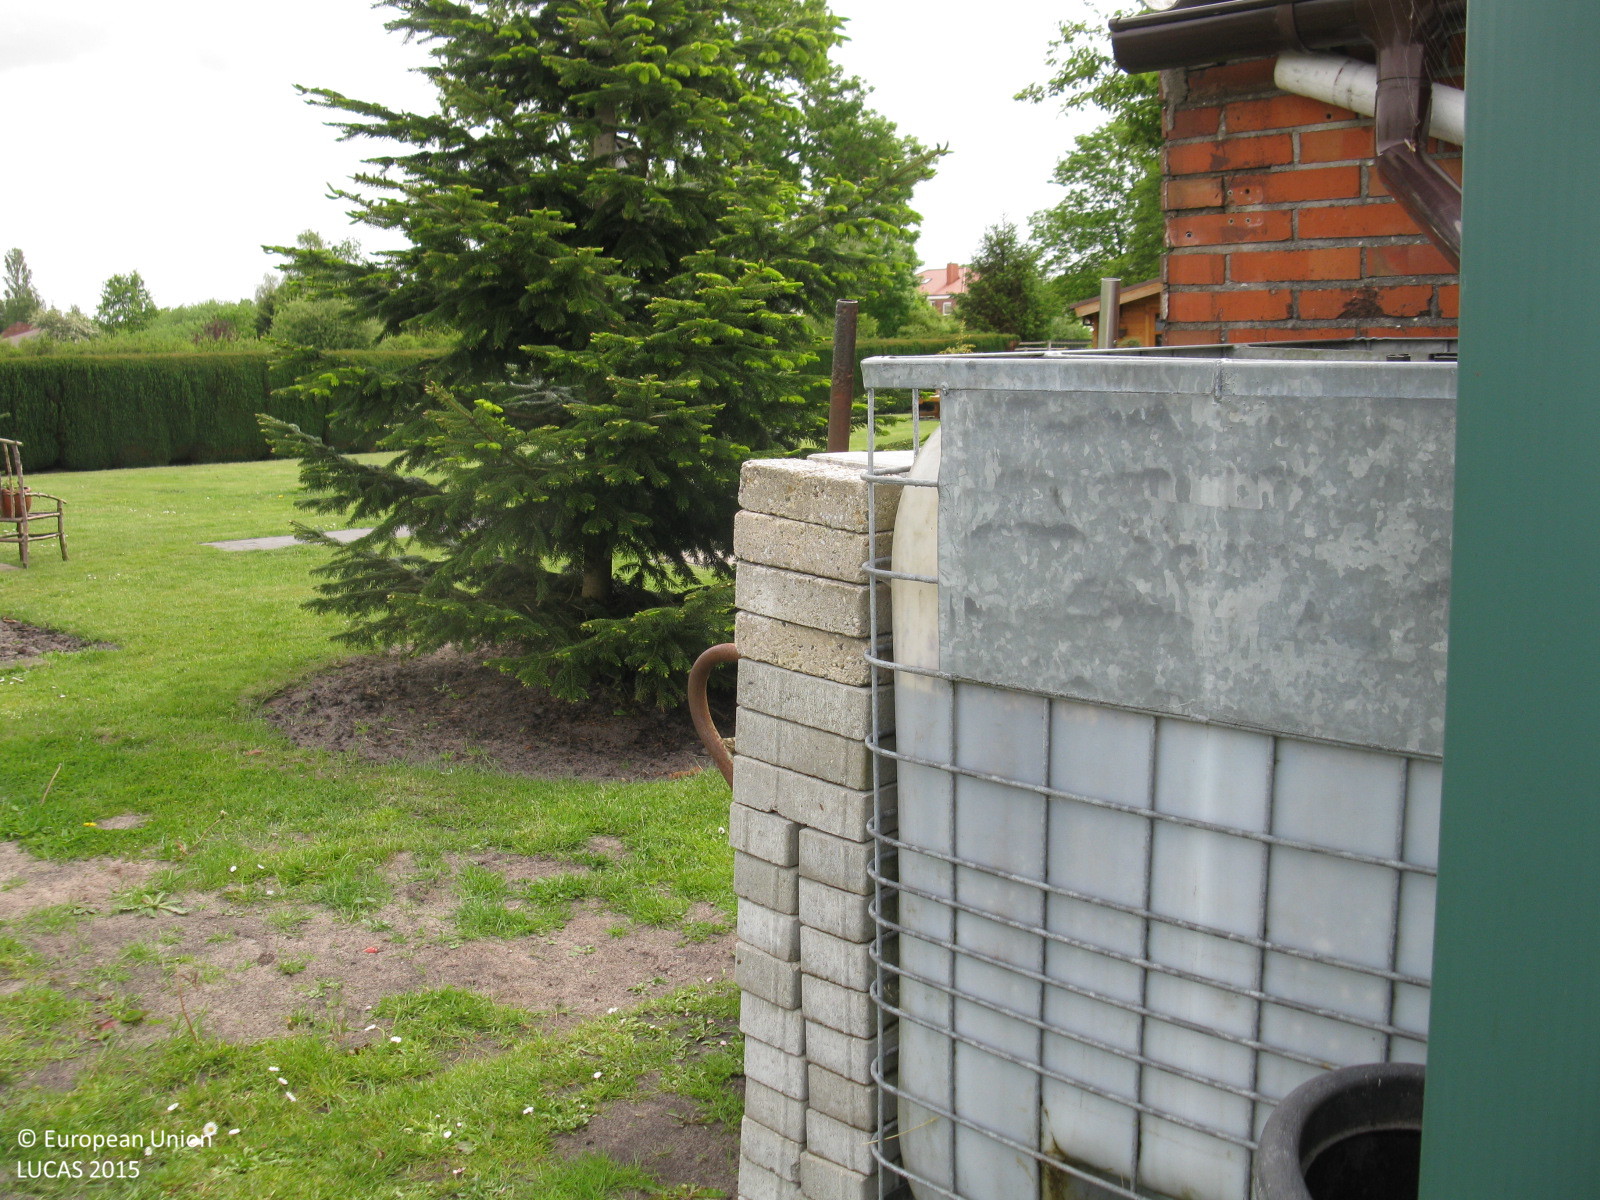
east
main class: Grassland
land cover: Grassland without tree/shrub cover
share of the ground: > 75 %
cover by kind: herbaceous plants 100 %
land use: Agriculture (excluding fallow land and kitchen gardens)
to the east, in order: Grassland without tree/shrub cover; Fences; Grassland without tree/shrub cover; Fences; Grass margins; Ditches and canals; Fences; Grassland without tree/shrub cover; Fences; Grassland without tree/shrub cover; Broadleaved woodland; Grassland without tree/shrub cover; Grassland with sparse tree/shrub cover
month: June
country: DE
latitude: 53.1739
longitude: 7.2926
